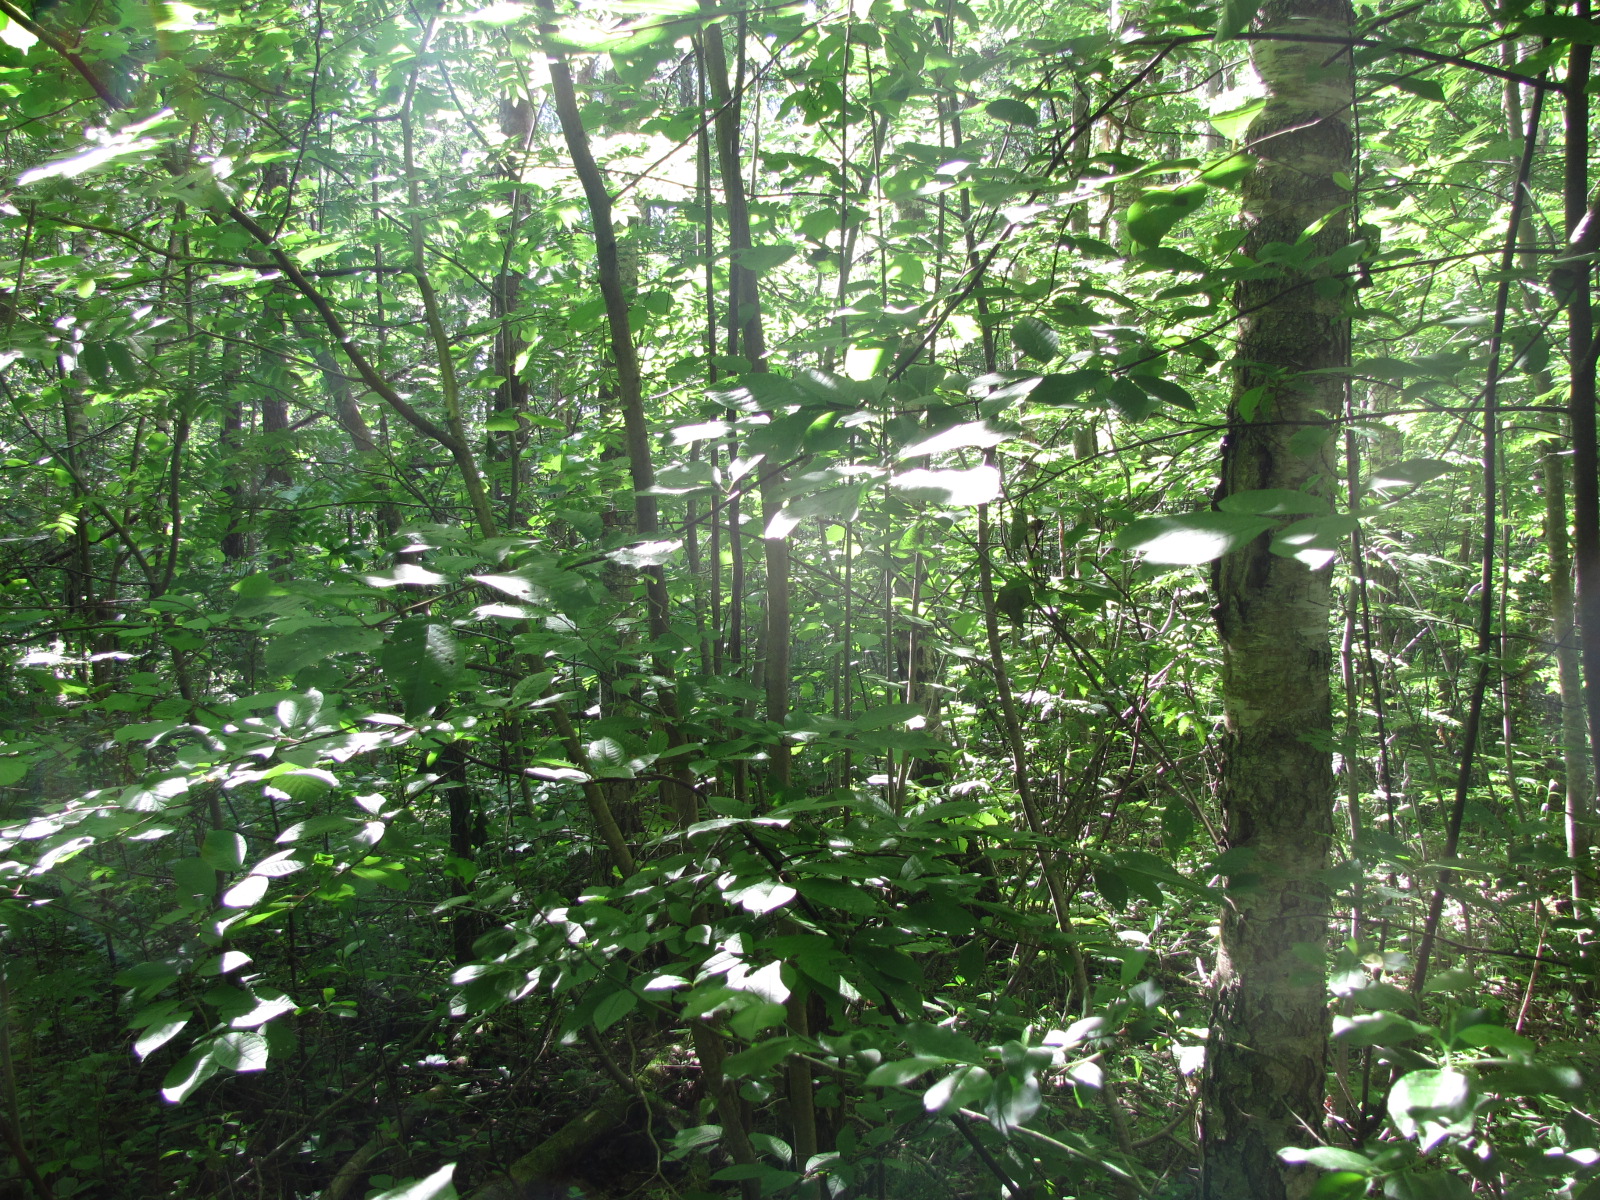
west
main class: Woodland
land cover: Broadleaved woodland
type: non-riverine alder, birch or aspen forest
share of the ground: > 75 %
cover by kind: broadleaved forest trees 100 %
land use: Forestry
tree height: > 5 m
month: June
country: LV
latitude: 56.8725
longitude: 24.3818
